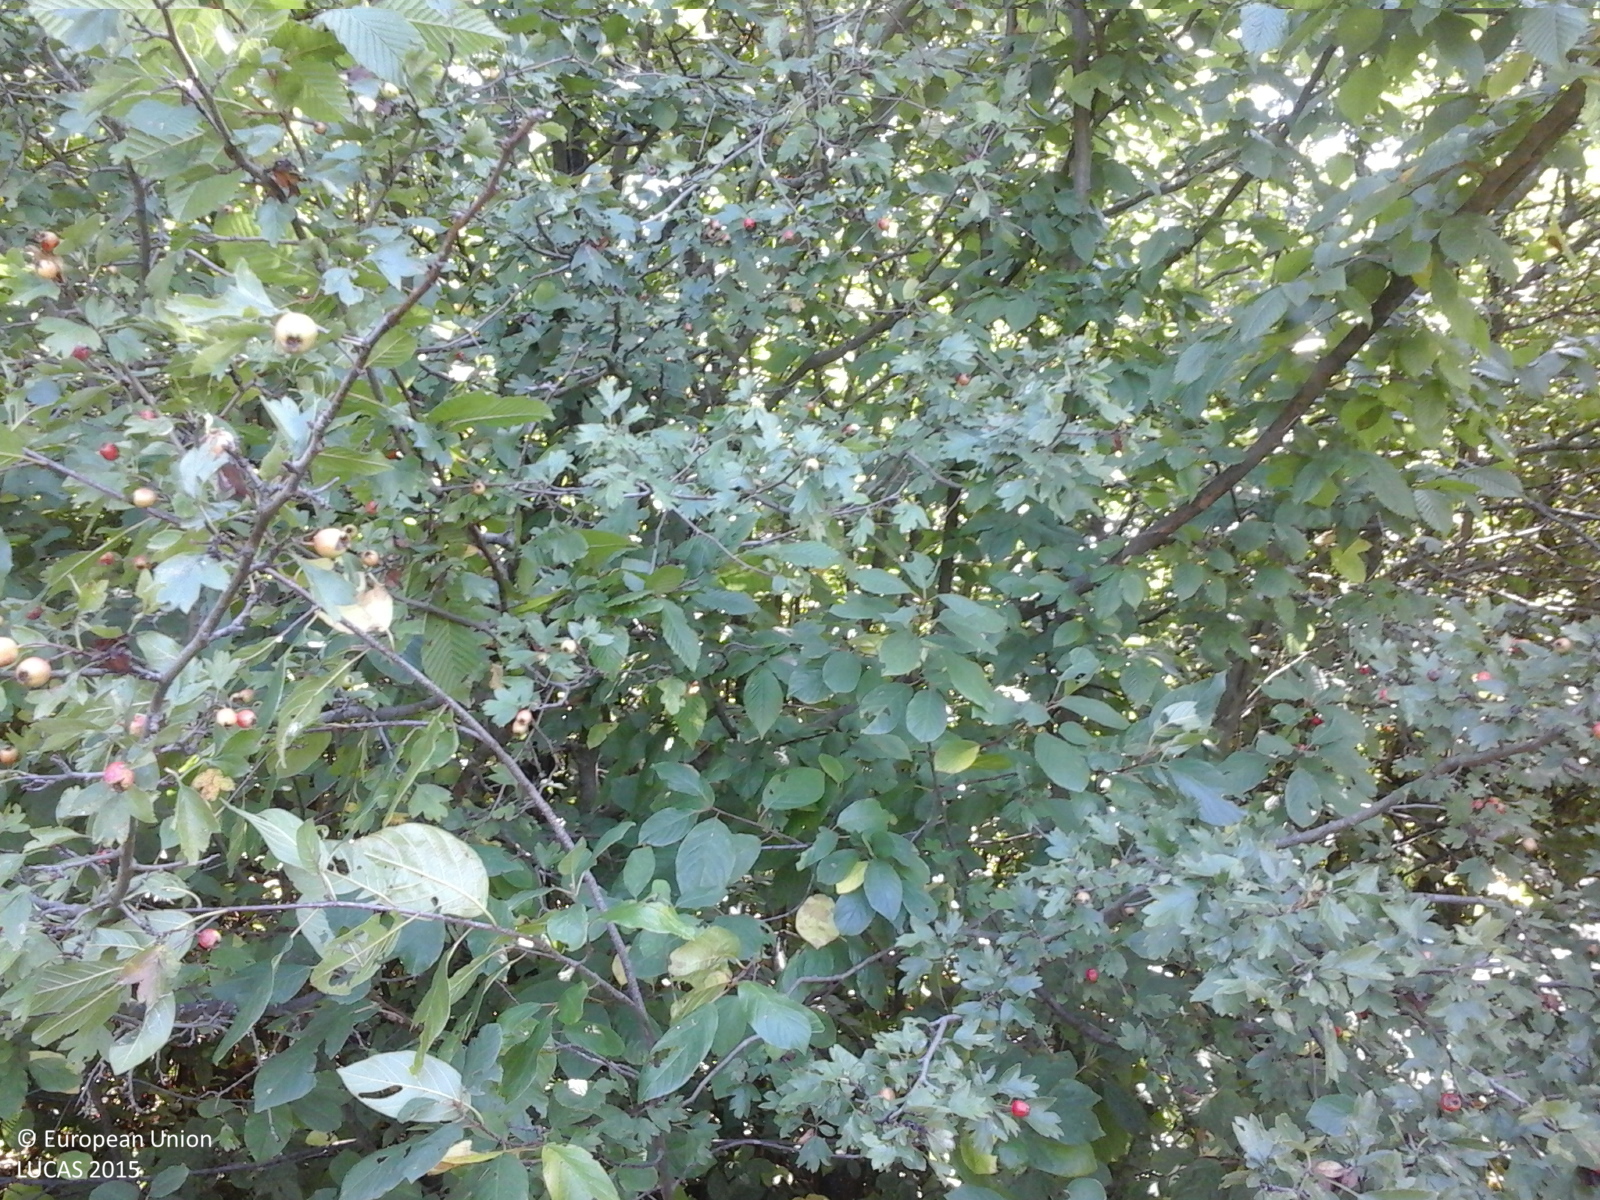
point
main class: Woodland
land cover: Broadleaved woodland
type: beech forest
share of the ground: > 75 %
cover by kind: broadleaved forest trees 100 %
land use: Forestry
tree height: > 5 m
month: September
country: RO
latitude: 47.3717
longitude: 23.4881
